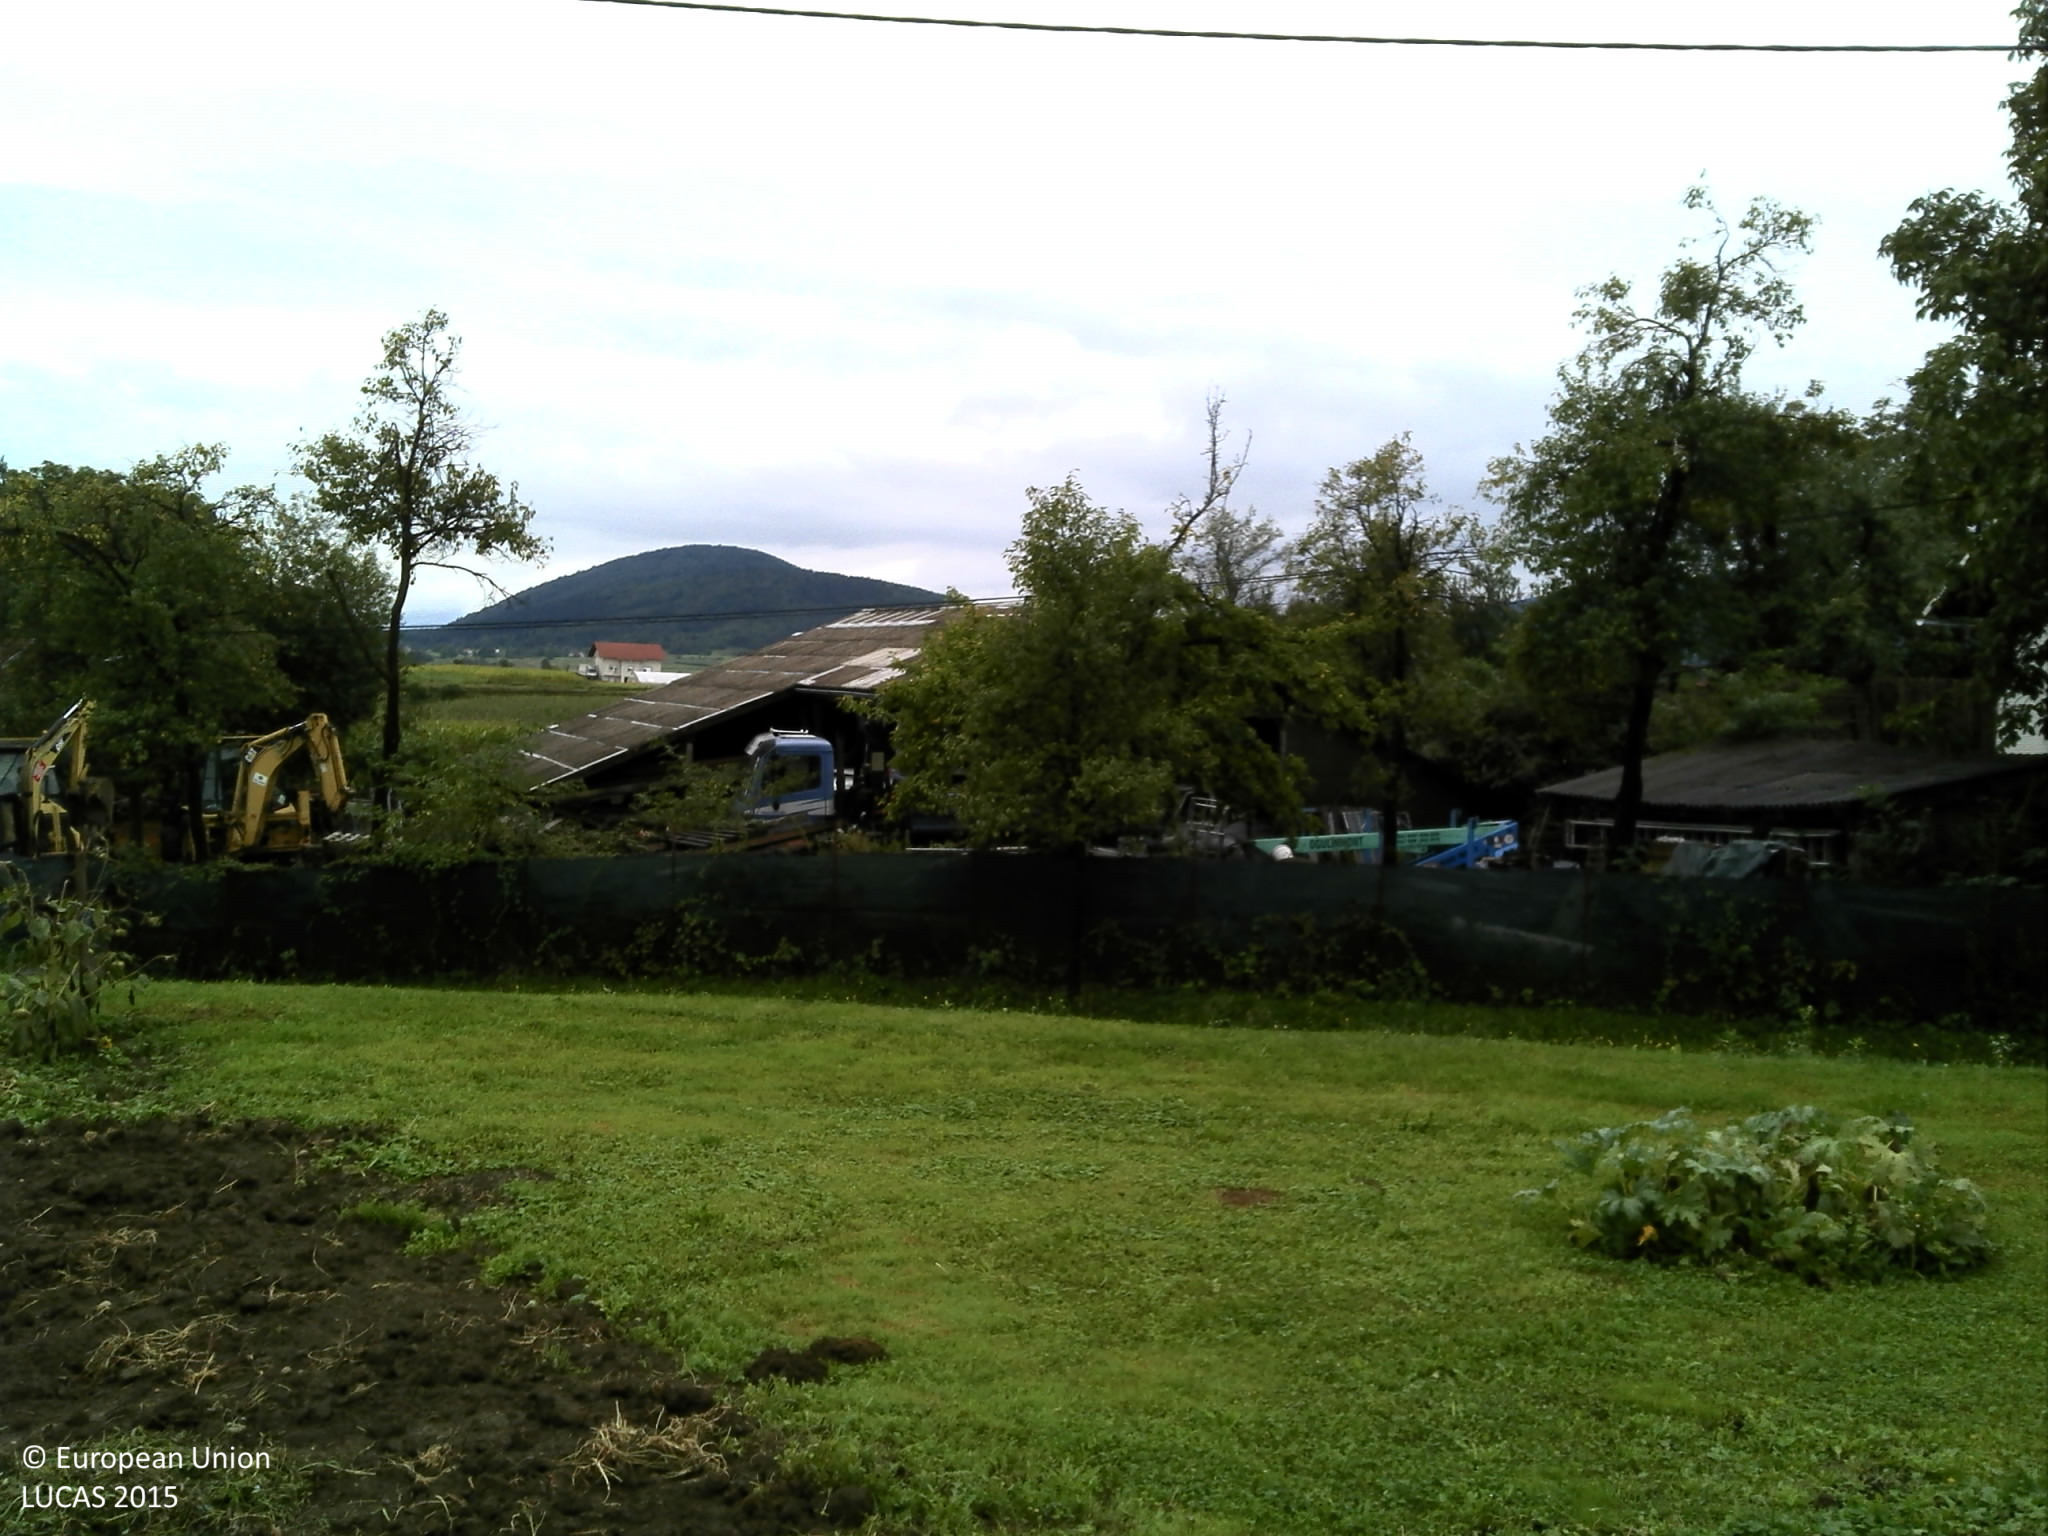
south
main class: Grassland
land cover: Grassland without tree/shrub cover
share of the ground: > 75 %
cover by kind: herbaceous plants 100 %
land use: Residential
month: September
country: HR
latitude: 45.2483
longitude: 15.2318
